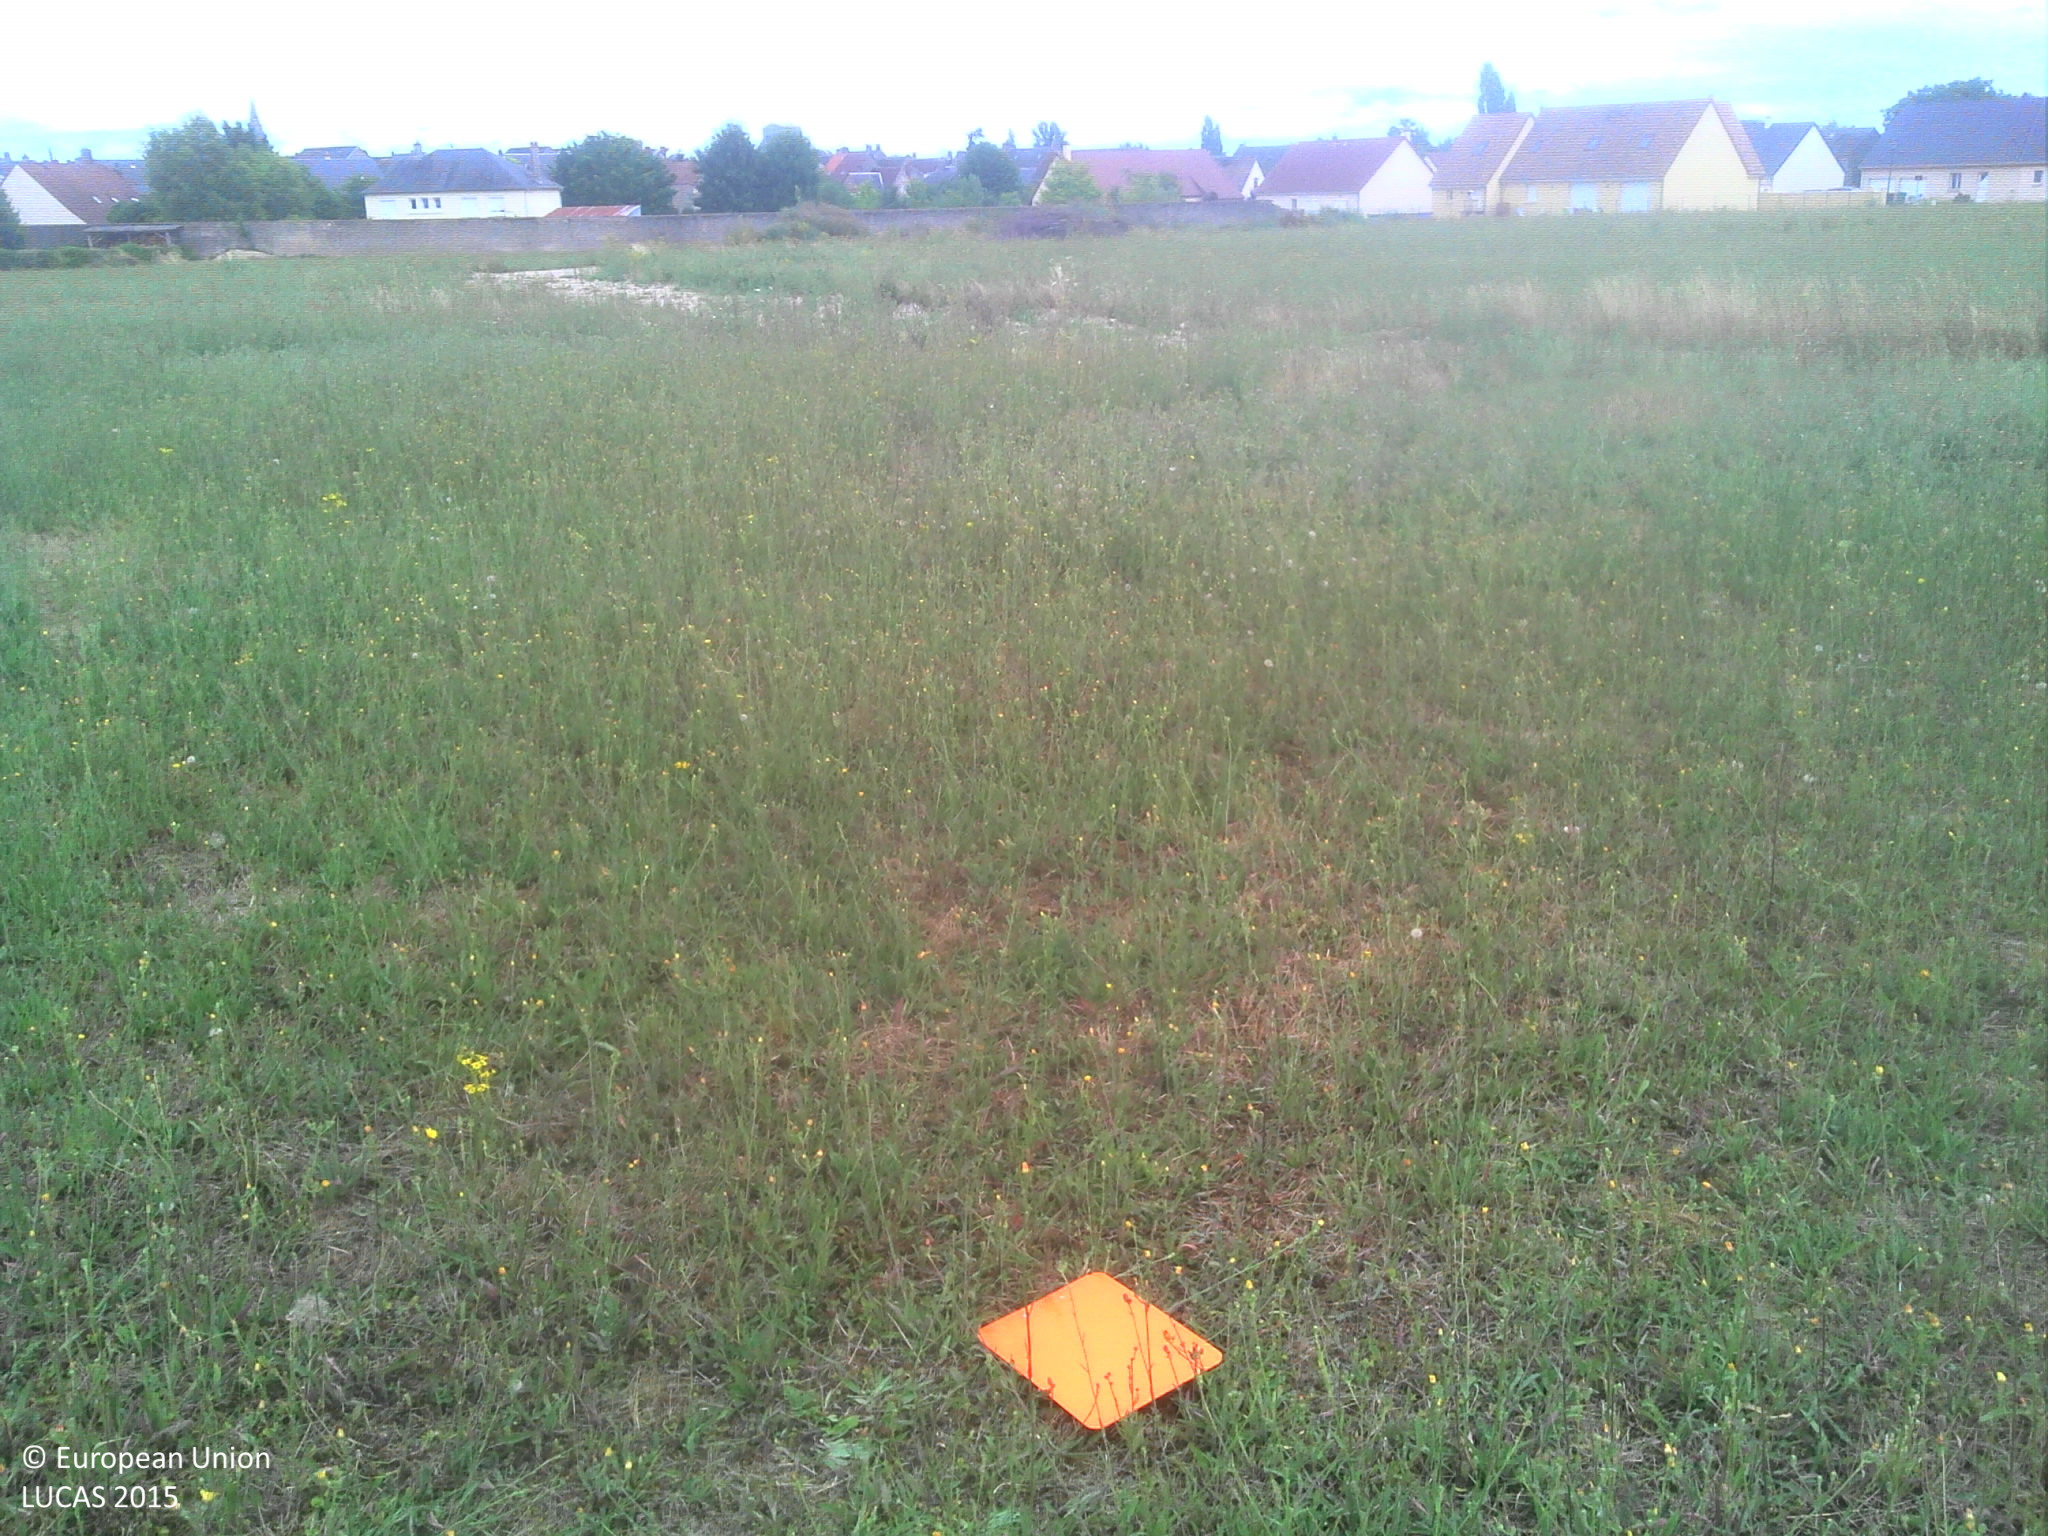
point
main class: Grassland
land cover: Grassland without tree/shrub cover
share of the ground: > 75 %
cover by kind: herbaceous plants 100 %
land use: Semi-natural and natural areas not in use
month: July
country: FR
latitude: 47.8238
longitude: 1.2880
